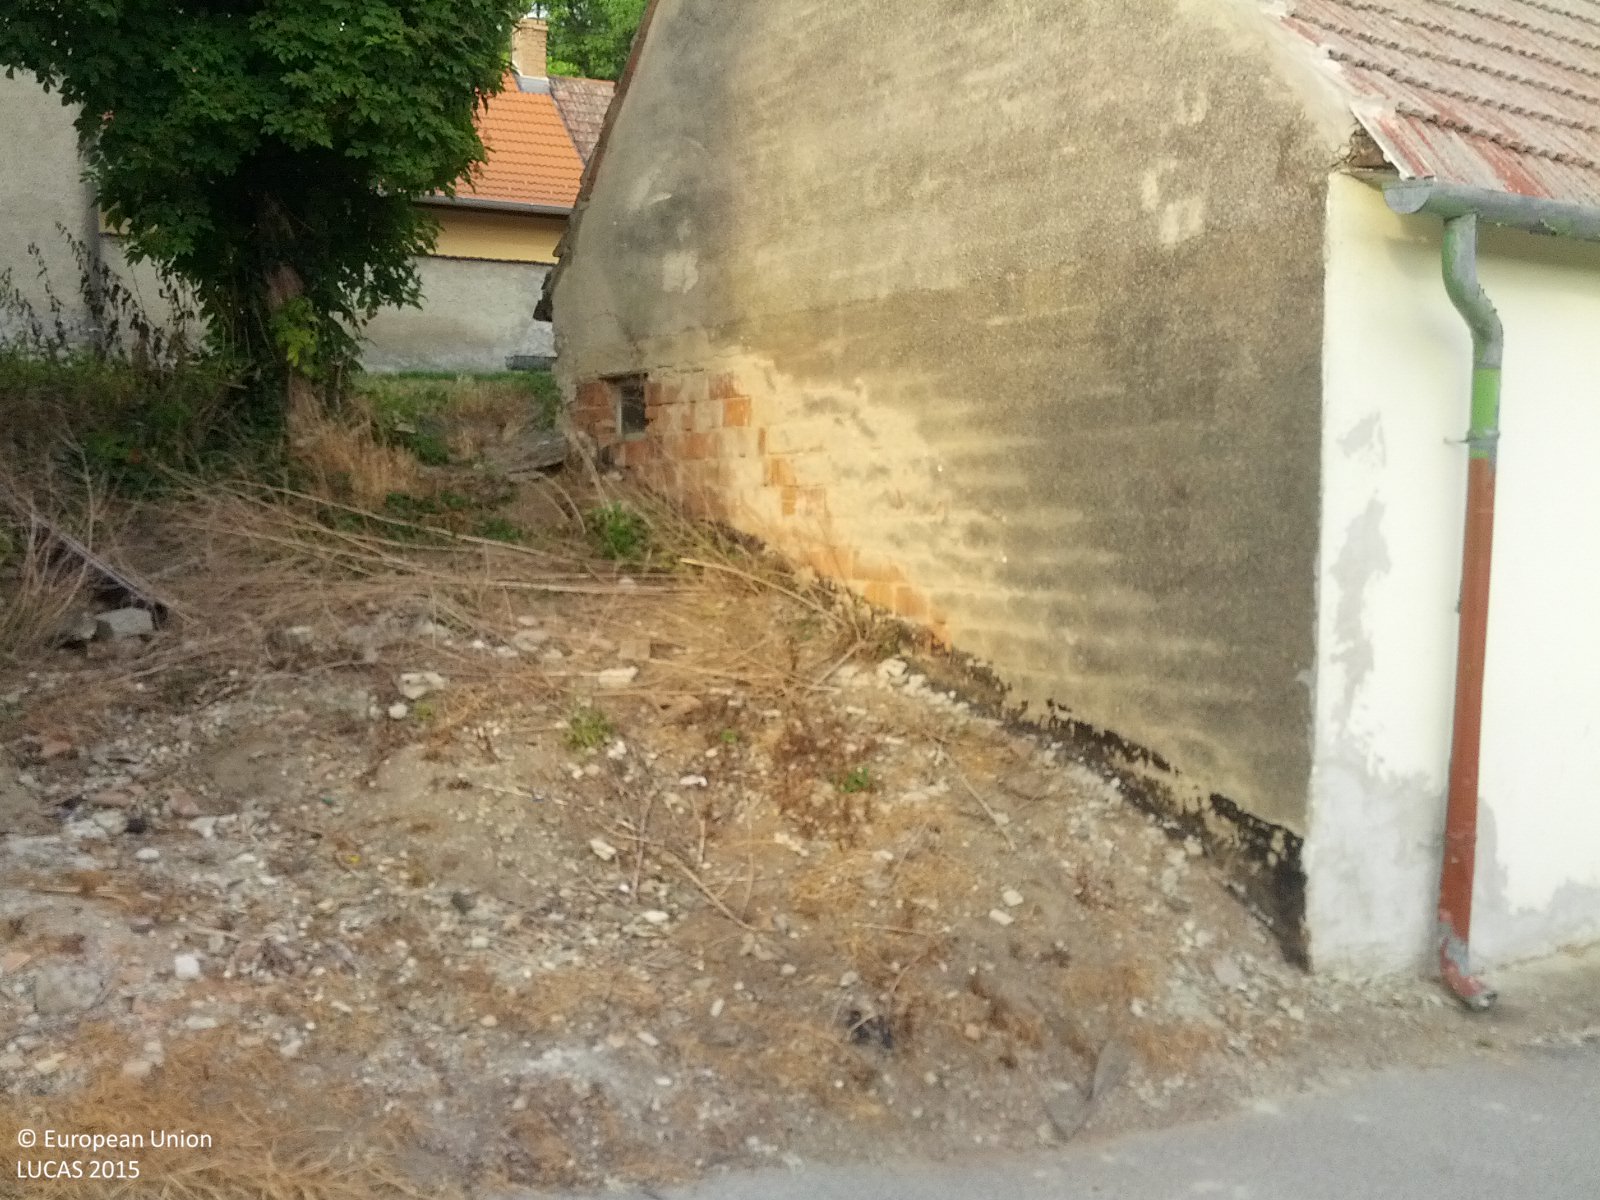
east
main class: Grassland
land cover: Grassland with sparse tree/shrub cover
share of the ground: > 75 %
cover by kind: herbaceous plants 80 %, shrubs 10 %, broadleaved forest trees 5 %, consolidated bare surface 5 %
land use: Residential
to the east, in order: Grassland with sparse tree/shrub cover; Artificial constructions in urban areas; Grass margins; Barley; Other fresh vegetables; Common wheat; Grassland without tree/shrub cover; Sugar beet
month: June
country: AT
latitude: 48.6255
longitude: 16.8319
